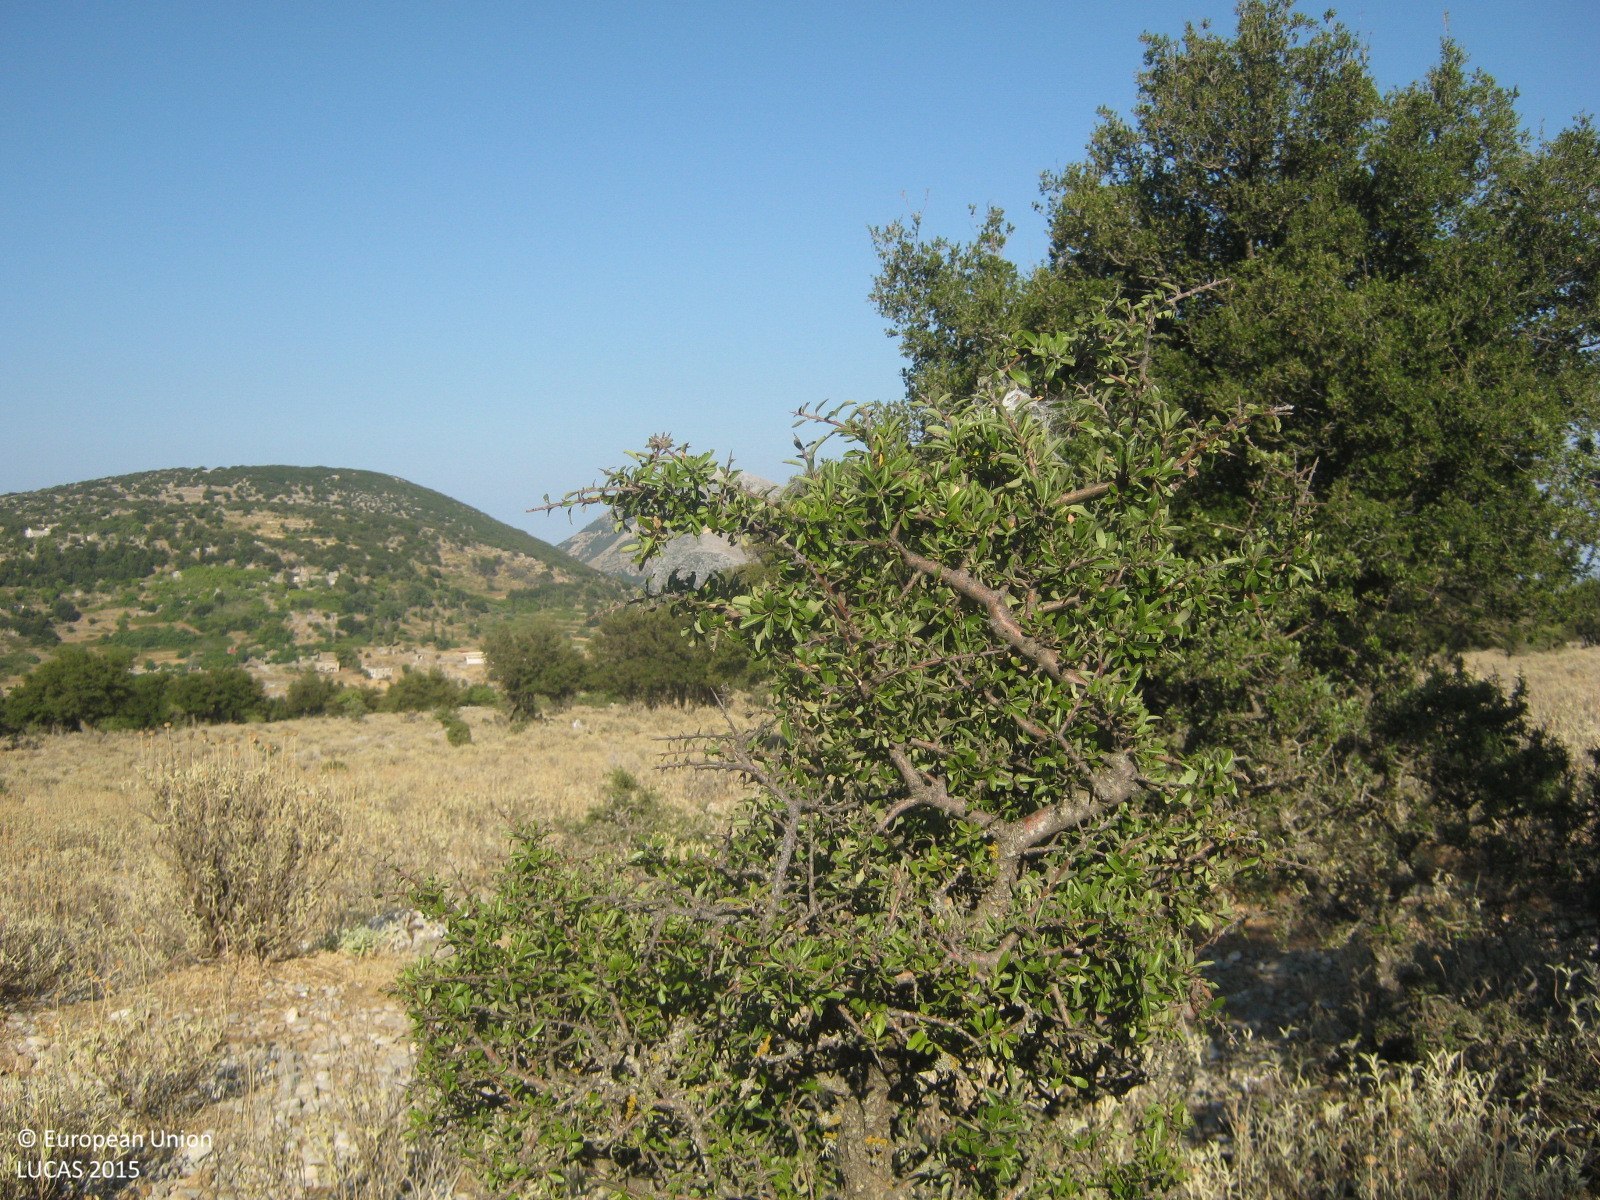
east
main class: Grassland
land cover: Grassland with sparse tree/shrub cover
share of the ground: > 75 %
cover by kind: herbaceous plants 75 %, shrubs 10 %, consolidated bare surface 10 %, broadleaved forest trees 5 %
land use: Semi-natural and natural areas not in use
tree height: < 5 m
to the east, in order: Grassland with sparse tree/shrub cover; Dry stone walls; Grassland with sparse tree/shrub cover; Dry stone walls; Grassland with sparse tree/shrub cover; Dry stone walls; Grassland with sparse tree/shrub cover
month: July
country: GR
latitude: 38.1678
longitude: 20.6791
